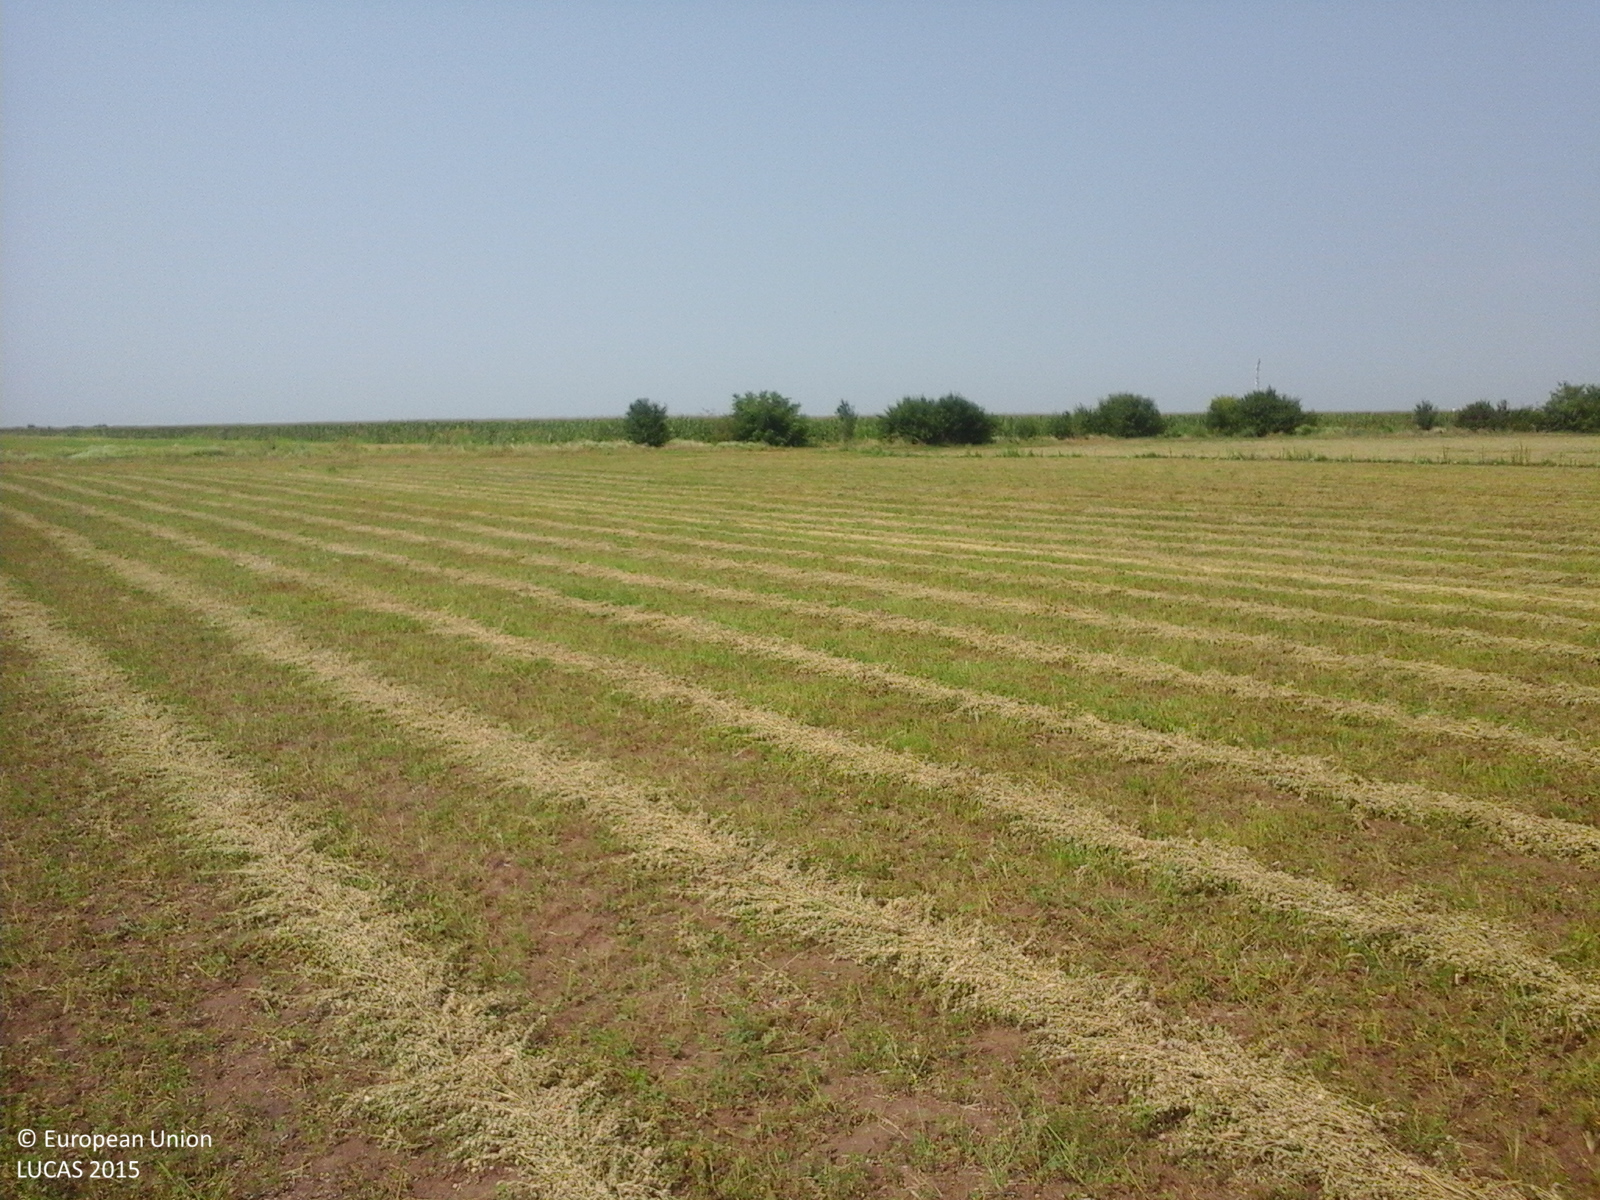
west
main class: Cropland
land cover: Lucerne
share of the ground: > 75 %
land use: Agriculture (excluding fallow land and kitchen gardens)
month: July
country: RO
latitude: 44.8163
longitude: 26.5207
